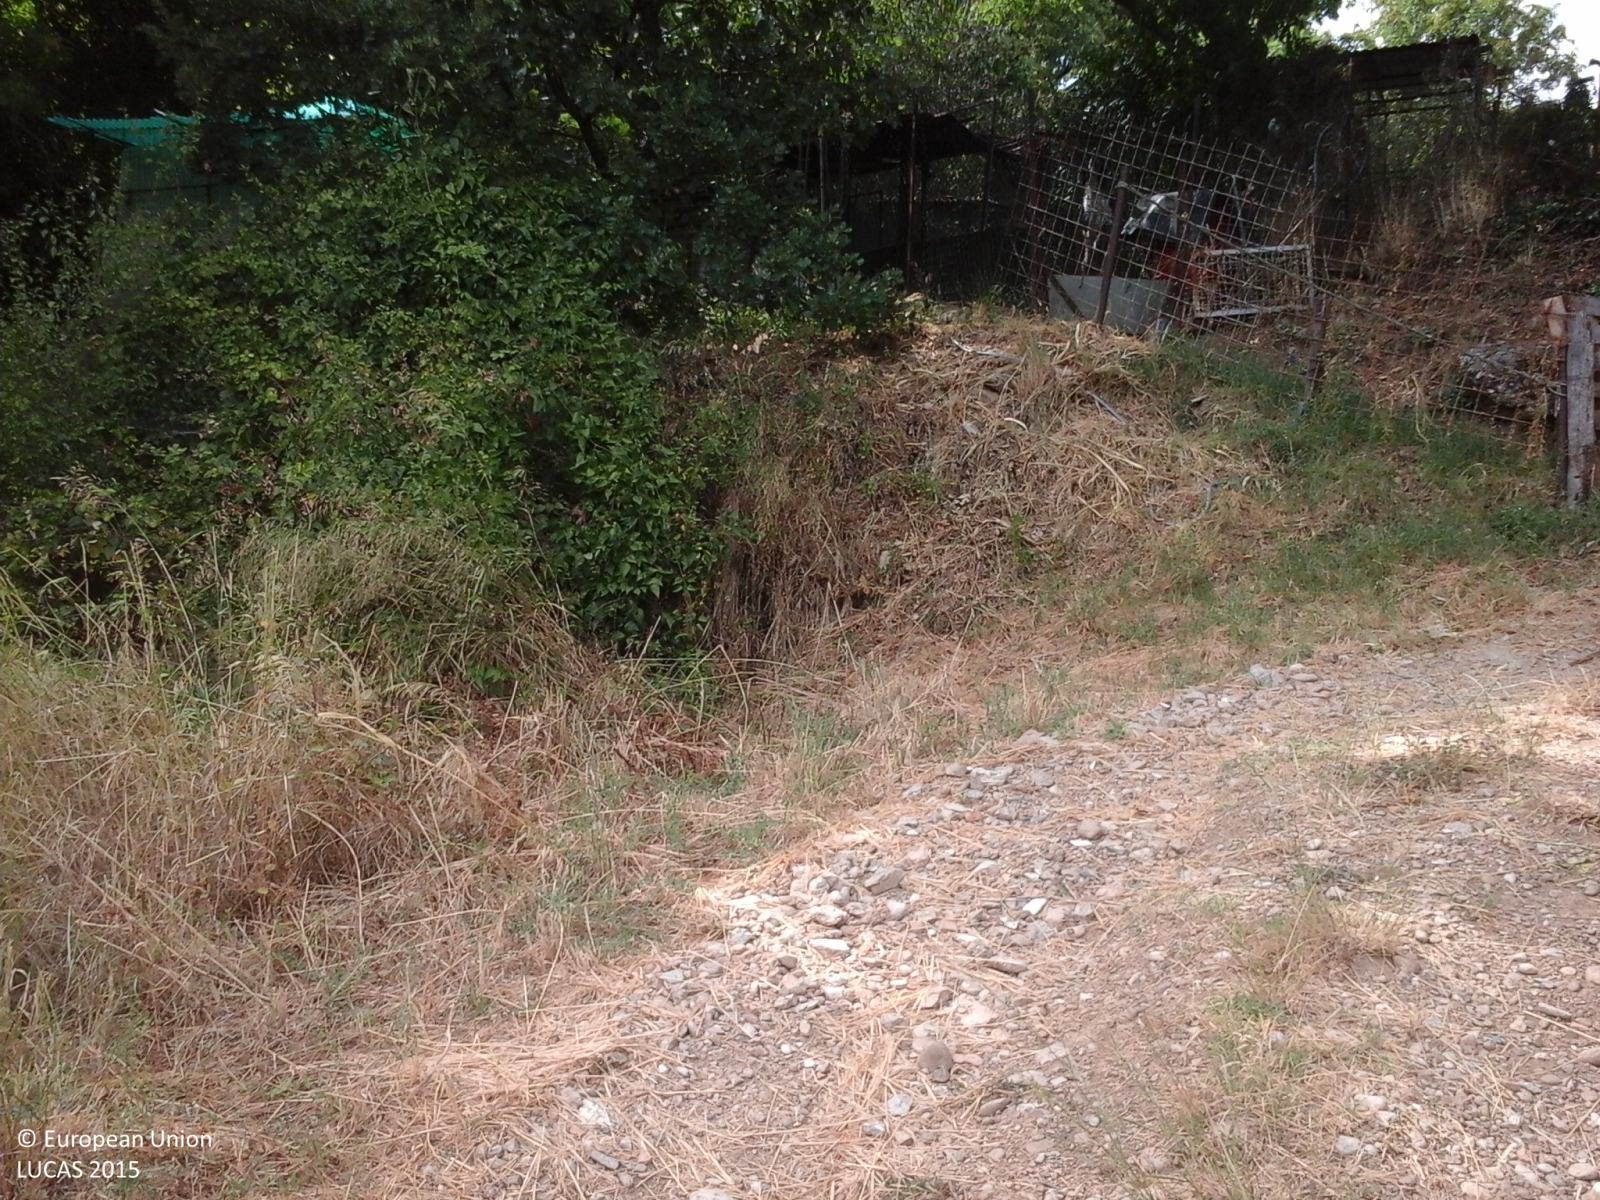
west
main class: Woodland
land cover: Broadleaved woodland
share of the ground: > 75 %
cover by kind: broadleaved forest trees 100 %
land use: Forestry
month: August
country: IT
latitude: 43.1922
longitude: 10.8465
